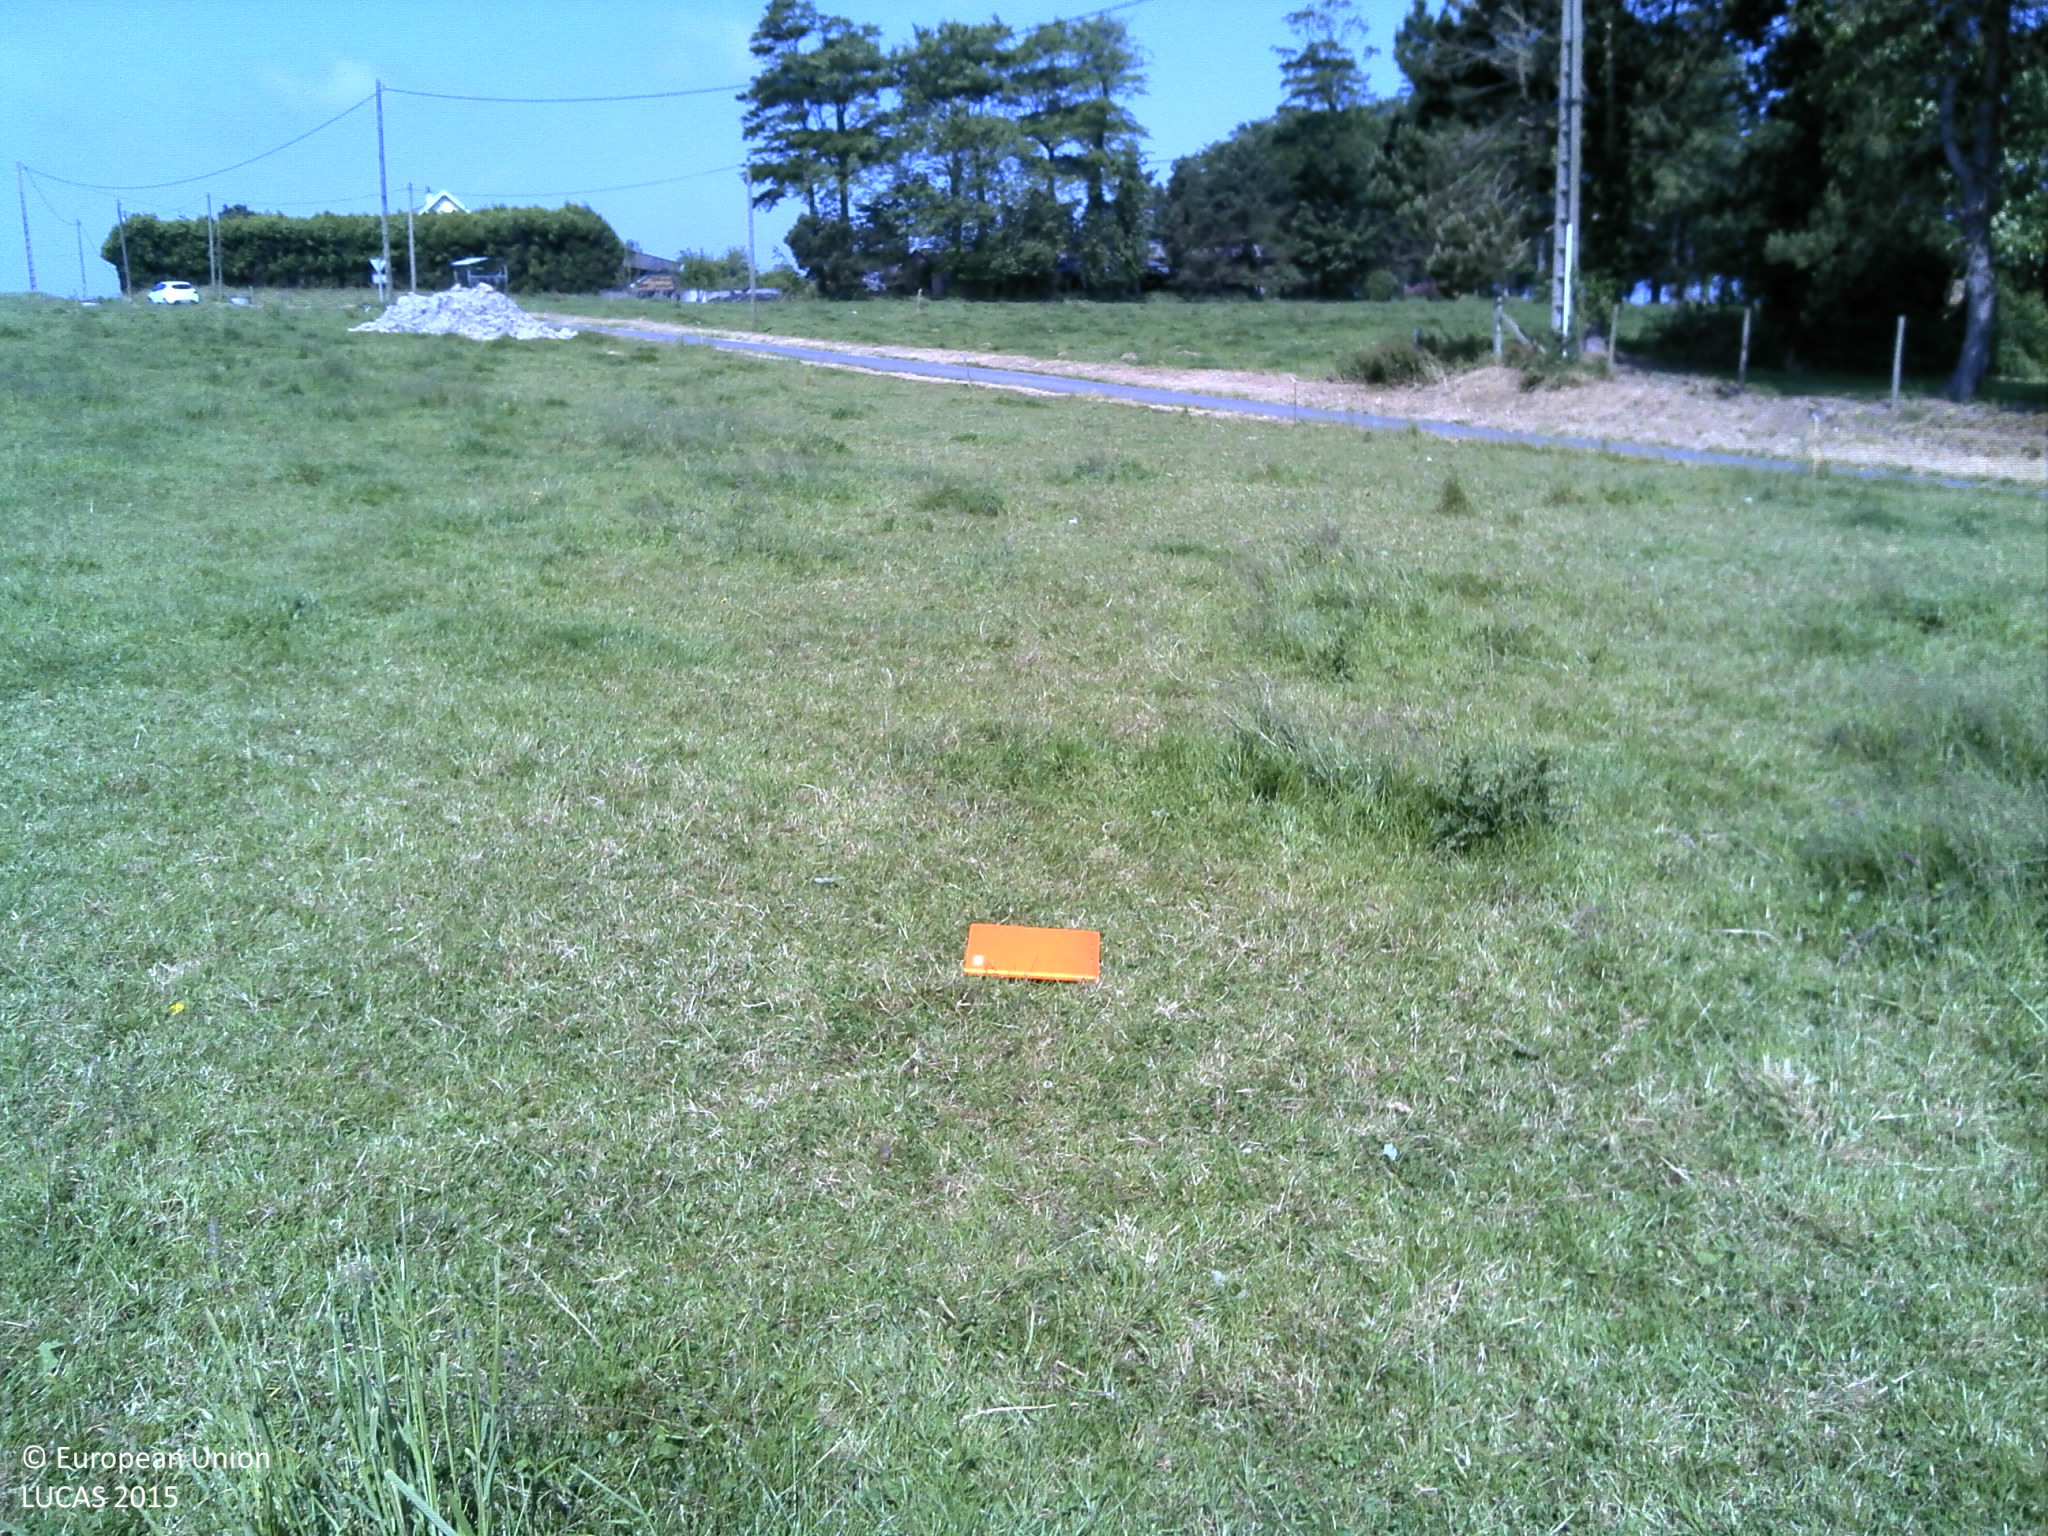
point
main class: Grassland
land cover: Grassland without tree/shrub cover
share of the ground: > 75 %
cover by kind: herbaceous plants 100 %
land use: Agriculture (excluding fallow land and kitchen gardens)
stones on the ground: < 10 %
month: June
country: FR
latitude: 49.6576
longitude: 0.2601
